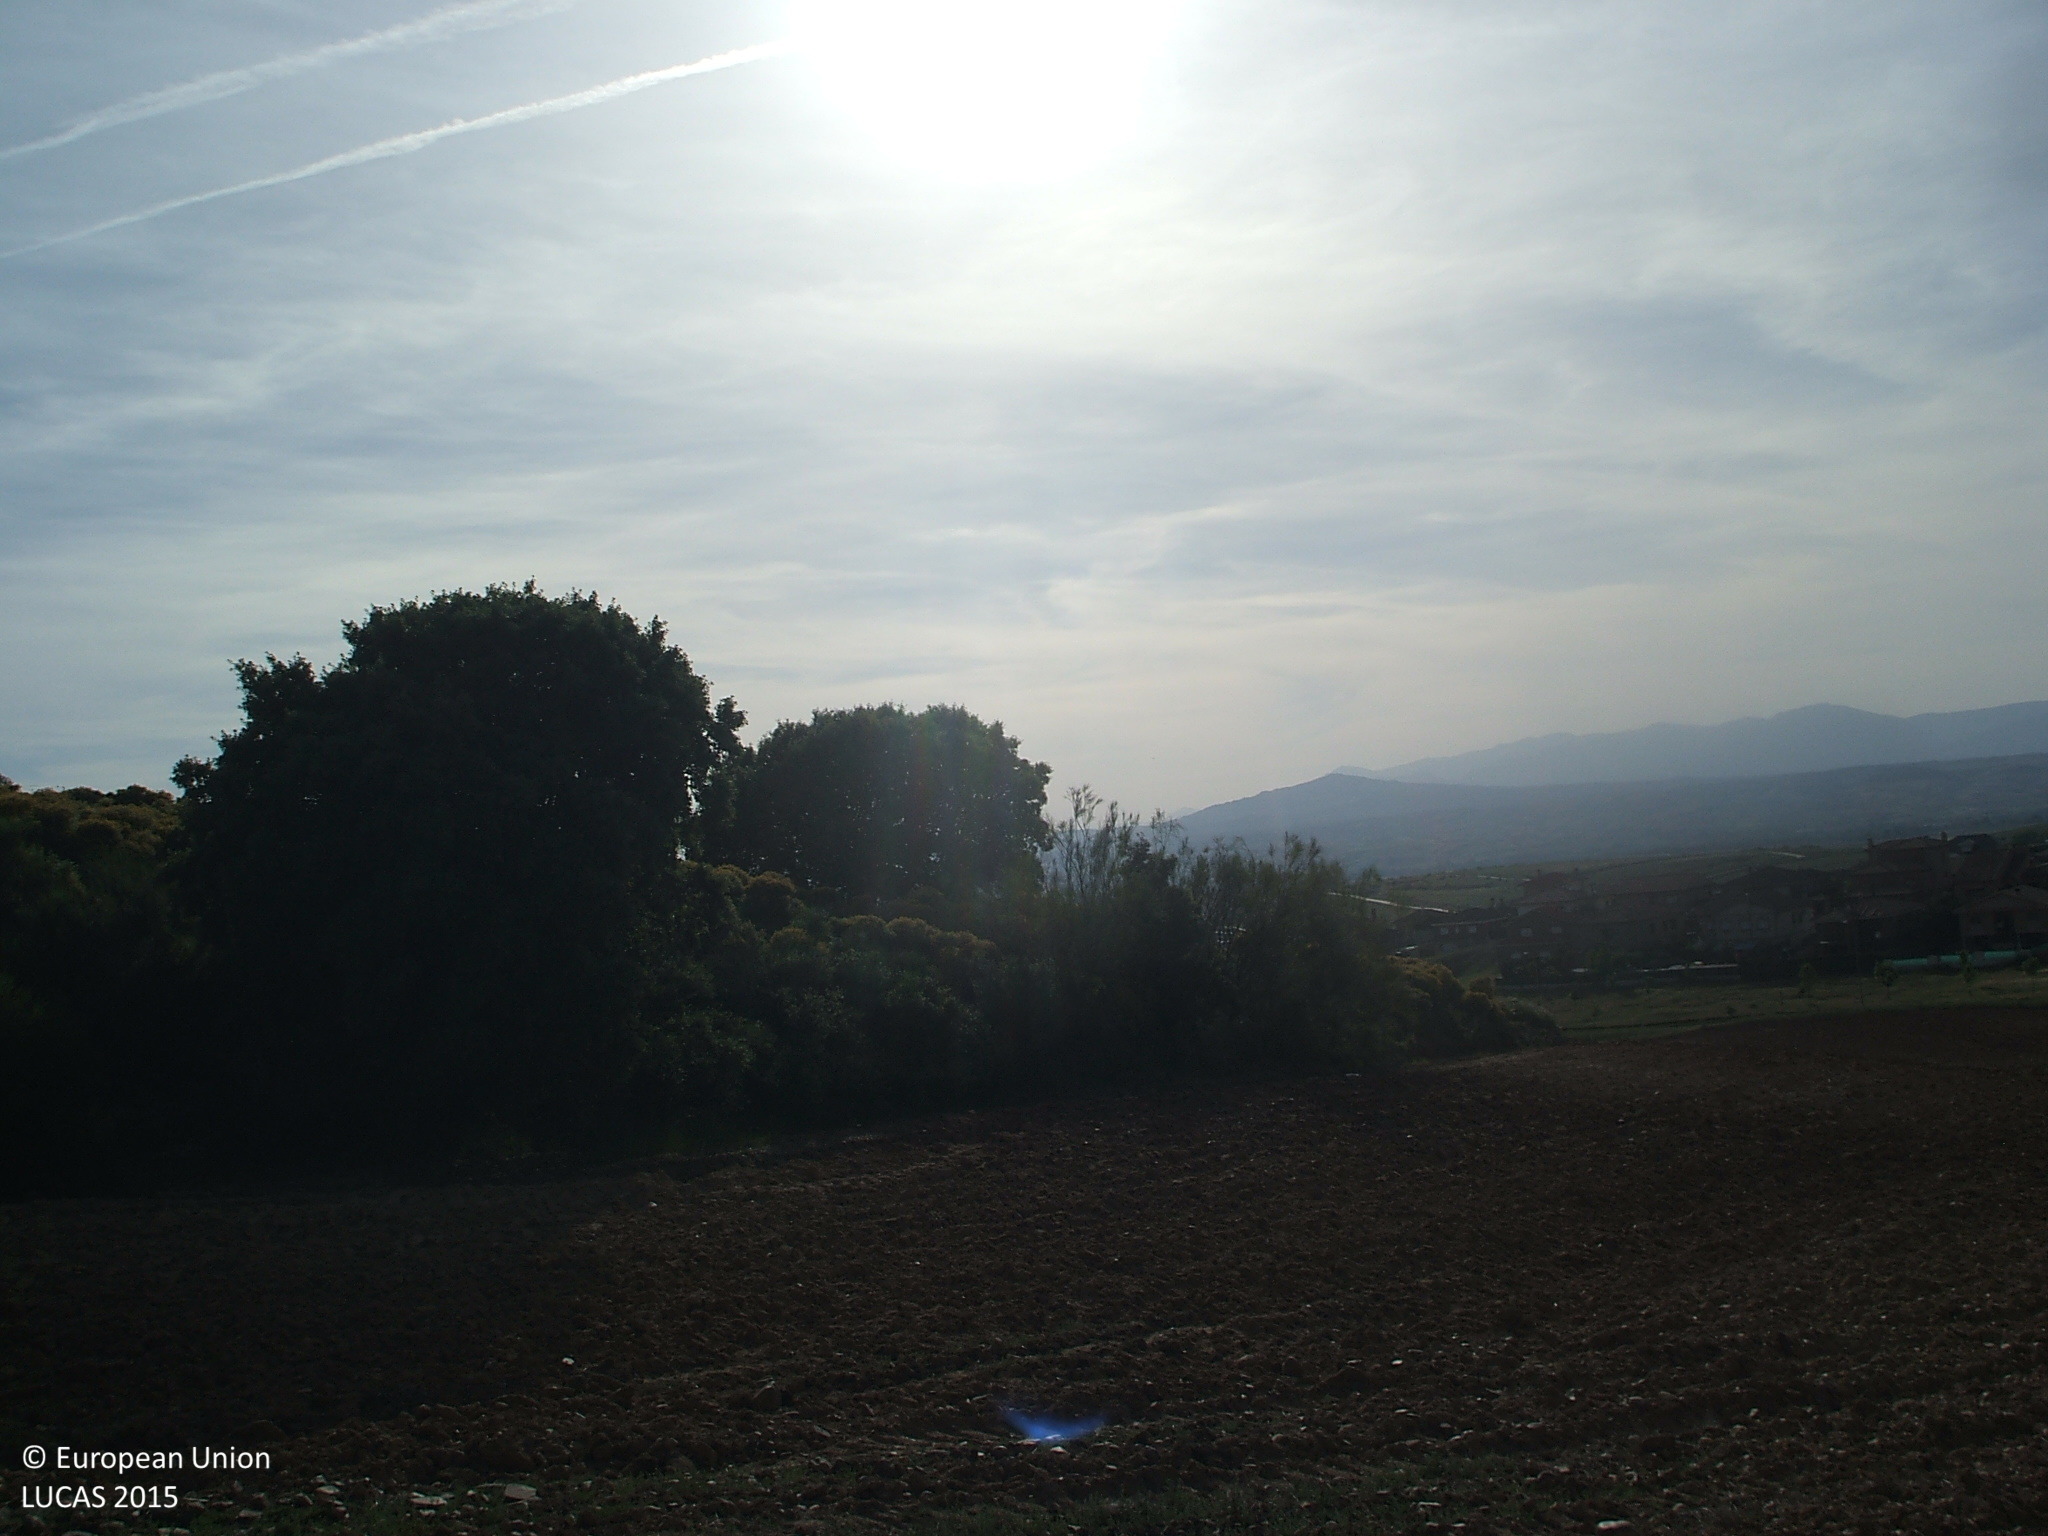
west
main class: Grassland
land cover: Grassland with sparse tree/shrub cover
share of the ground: > 75 %
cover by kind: herbaceous plants 95 %, broadleaved forest trees 5 %
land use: Abandoned areas
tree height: > 5 m
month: May
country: ES
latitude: 40.6921
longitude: -3.4451
